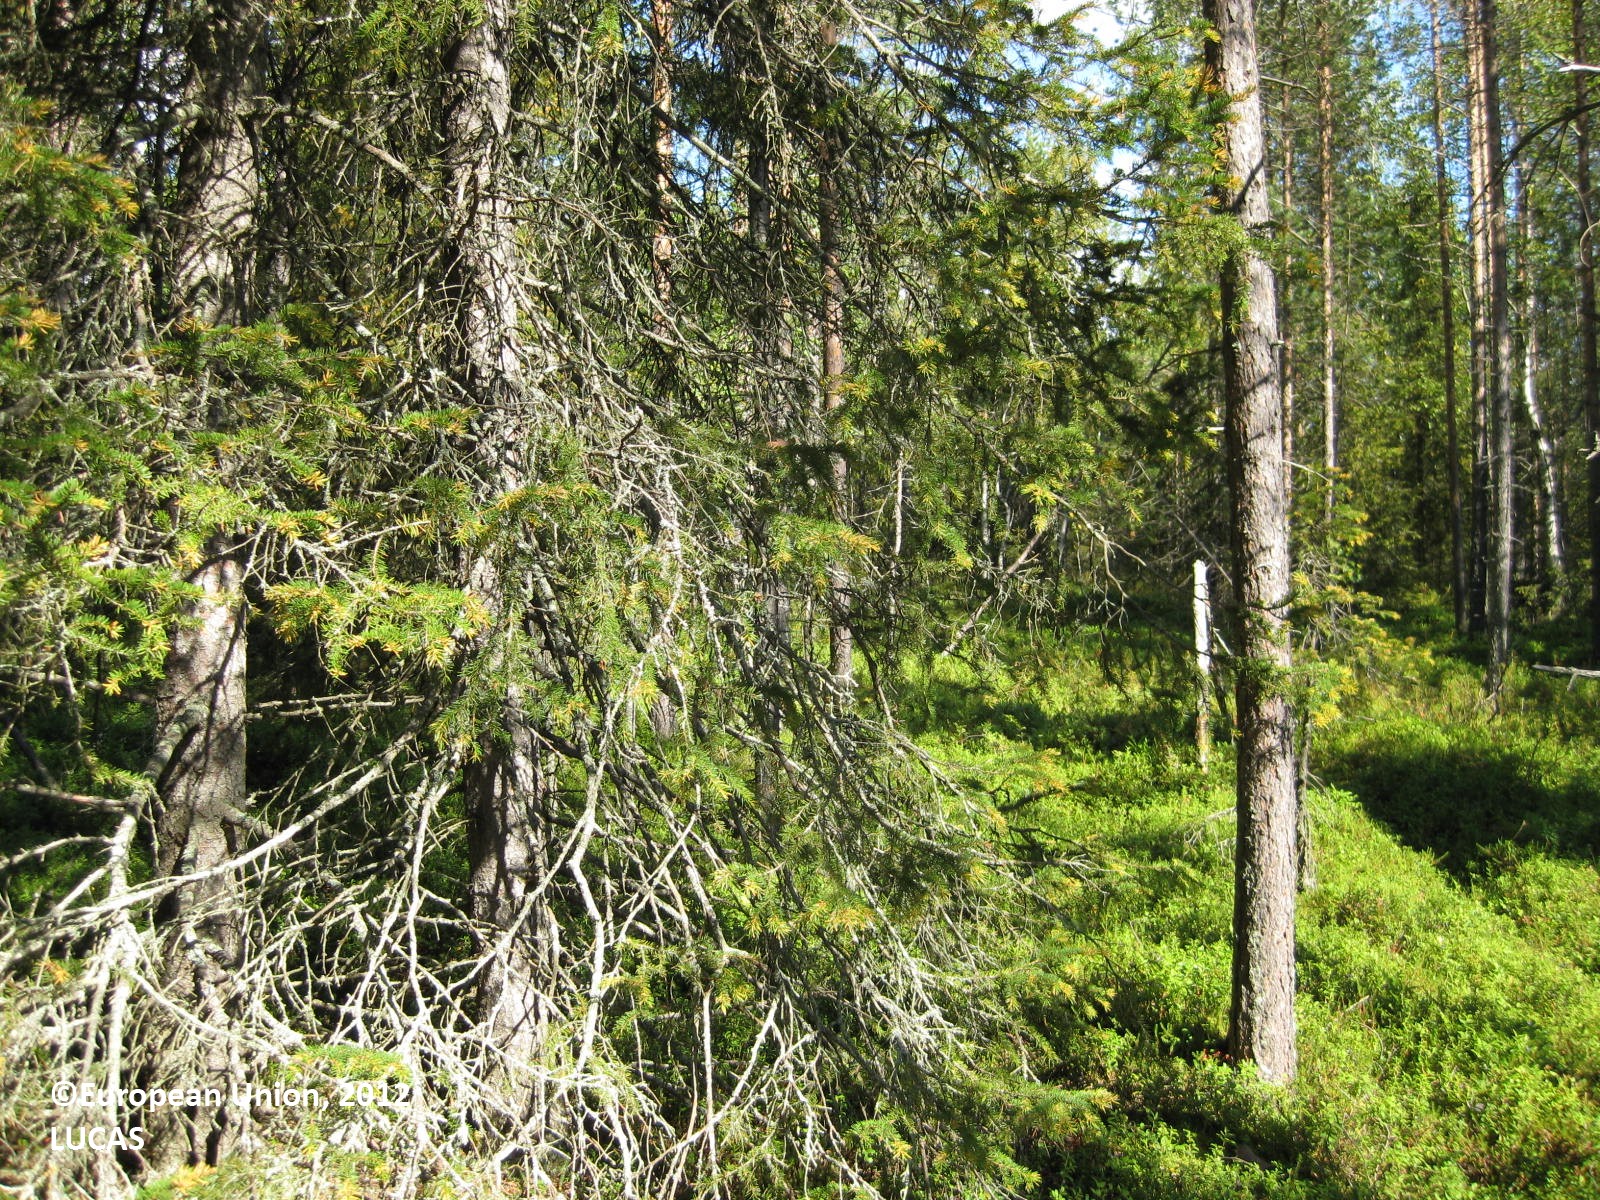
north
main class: Woodland
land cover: Other coniferous woodland
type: boreal forest
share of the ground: > 75 %
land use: Forestry
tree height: > 5 m
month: August
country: FI
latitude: 66.3557
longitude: 29.0489
